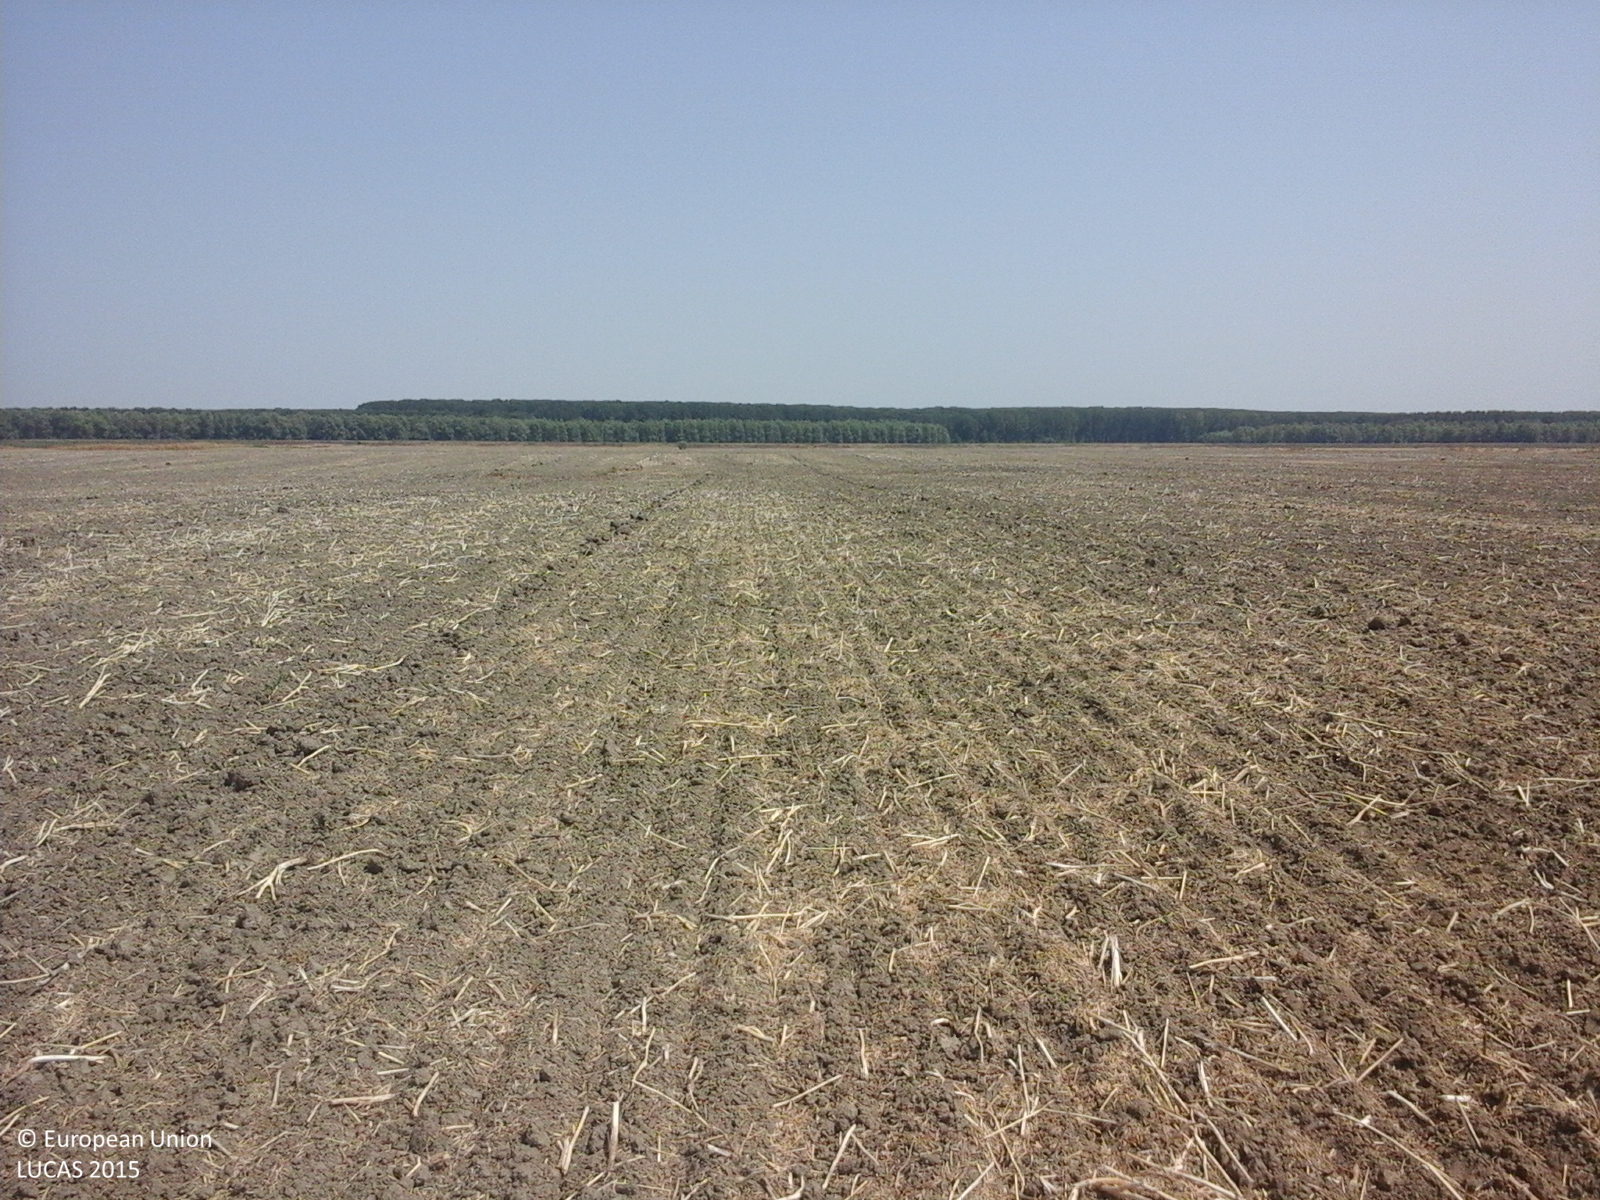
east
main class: Cropland
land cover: Rape and turnip rape
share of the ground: 10 - 25 %
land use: Agriculture (excluding fallow land and kitchen gardens)
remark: Harvested field
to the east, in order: Rape and turnip rape
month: August
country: RO
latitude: 45.0428
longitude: 28.1320
